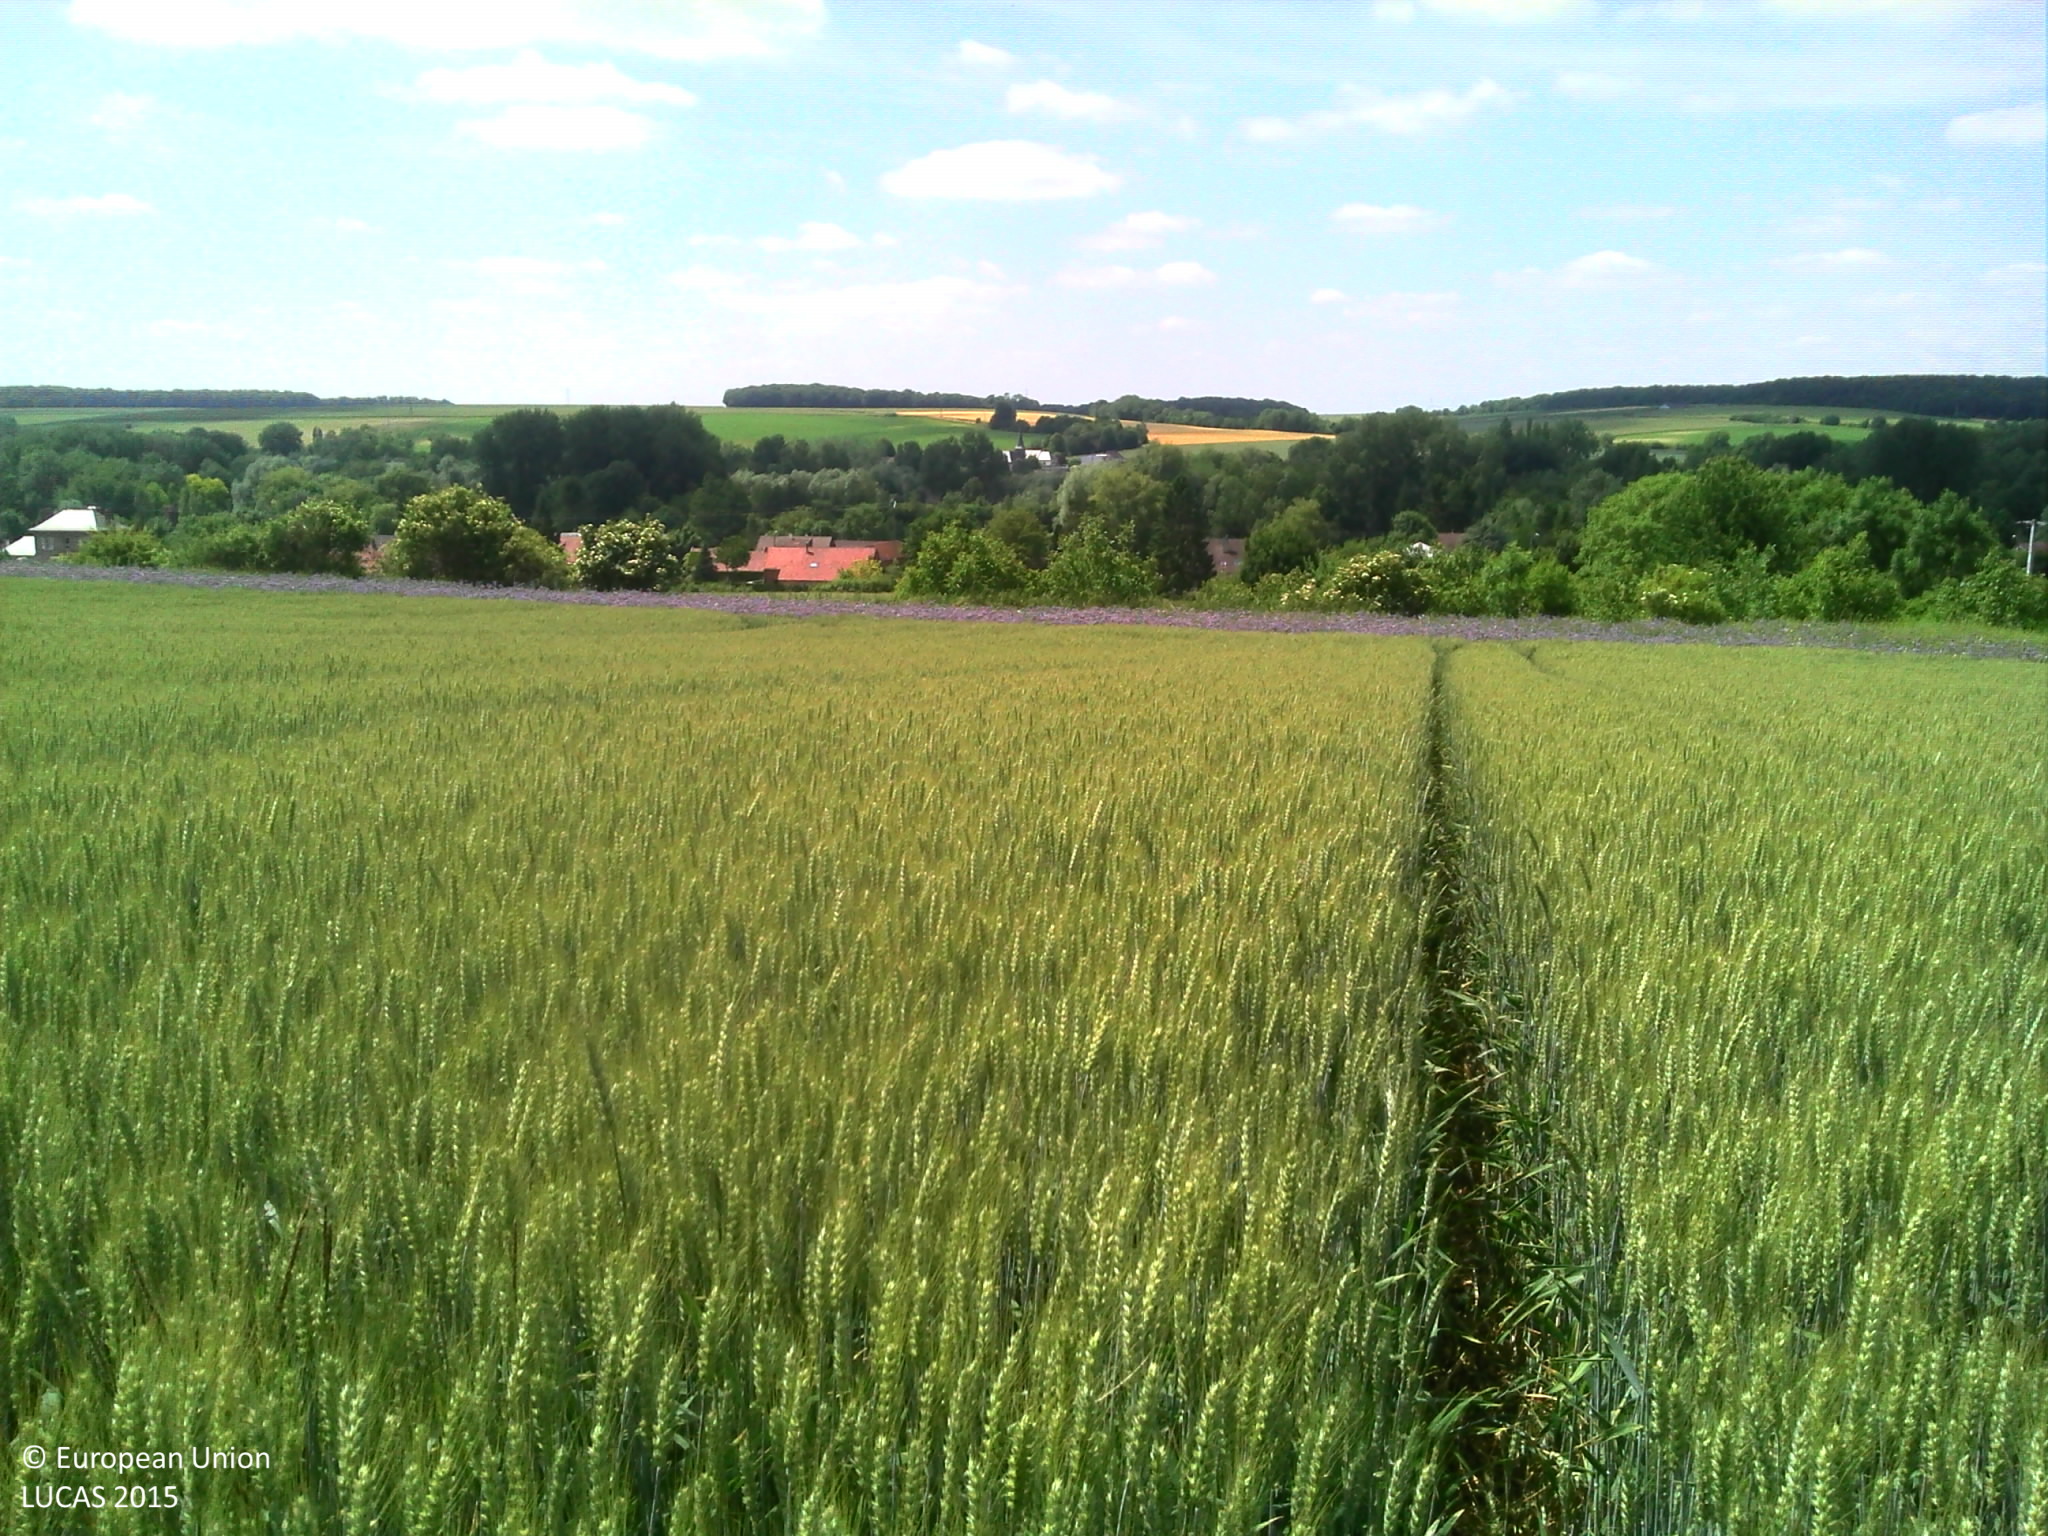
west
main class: Cropland
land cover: Durum wheat
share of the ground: > 75 %
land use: Agriculture (excluding fallow land and kitchen gardens)
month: June
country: FR
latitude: 49.6872
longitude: 2.5447
